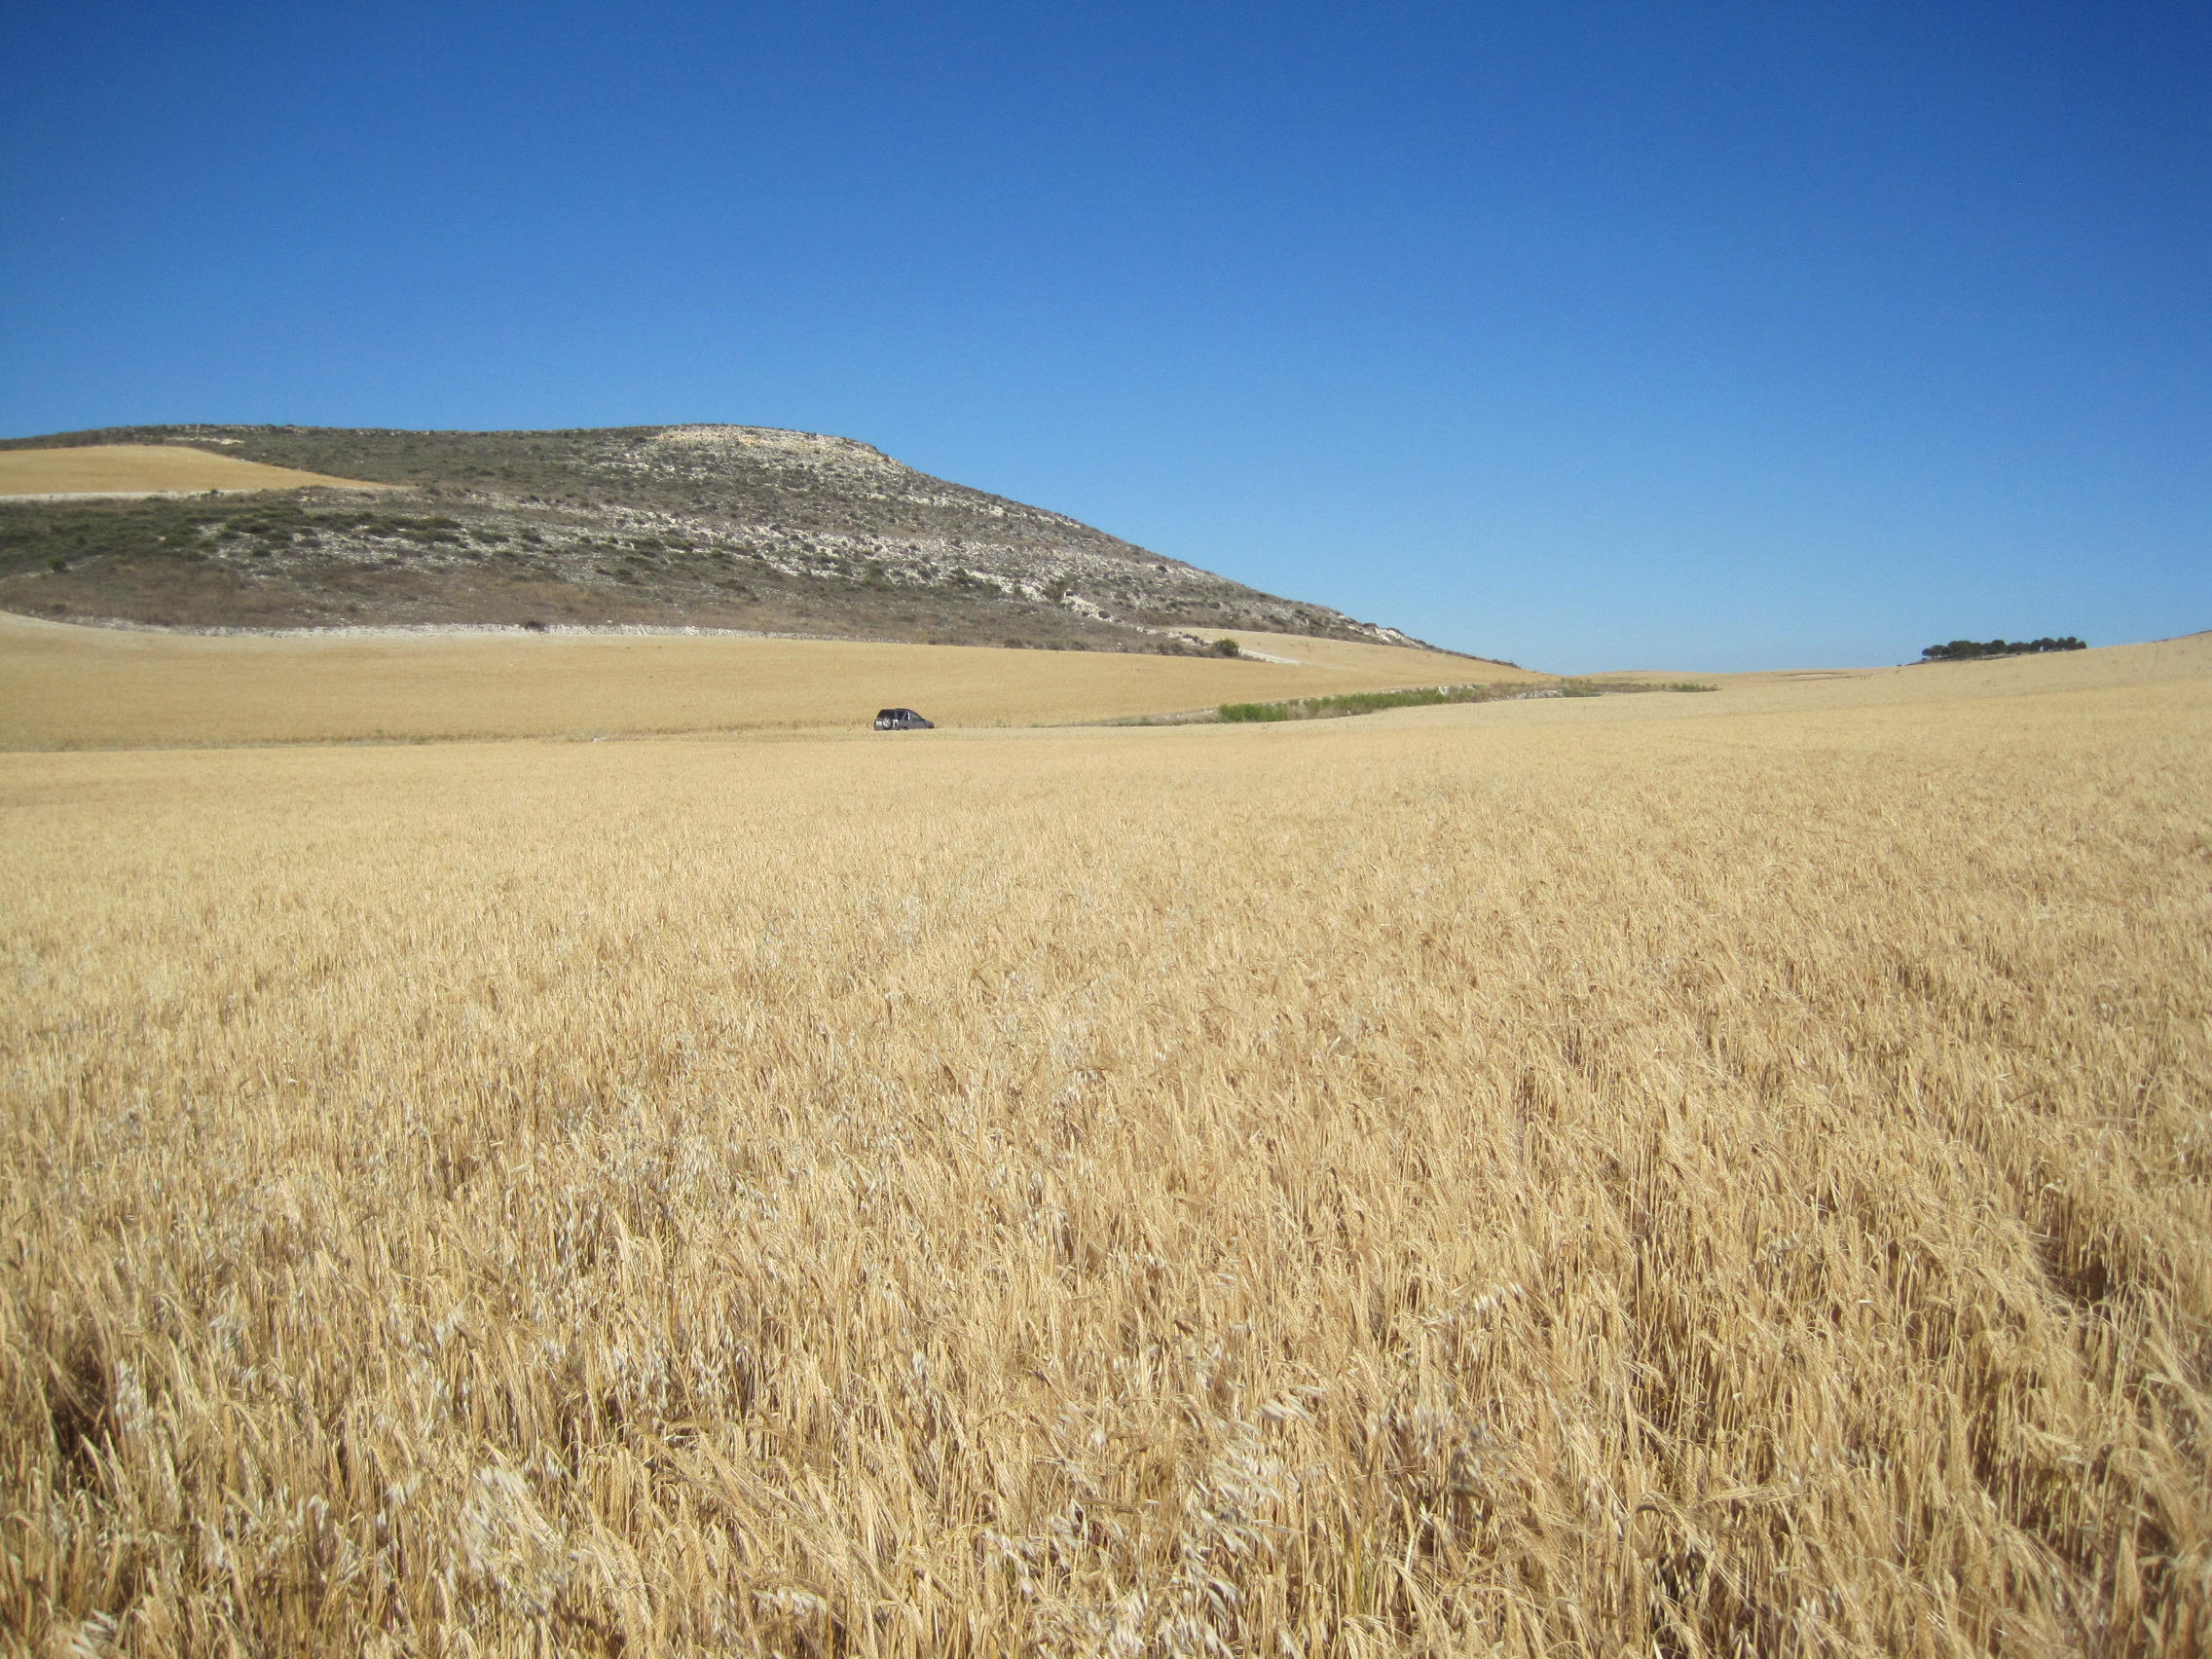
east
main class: Cropland
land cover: Barley
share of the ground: > 75 %
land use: Agriculture (excluding fallow land and kitchen gardens)
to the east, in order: Barley; Common wheat; Grass margins; Tracks; Grass margins; Barley; Grassland without tree/shrub cover
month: June
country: ES
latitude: 41.6400
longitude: -5.1188
